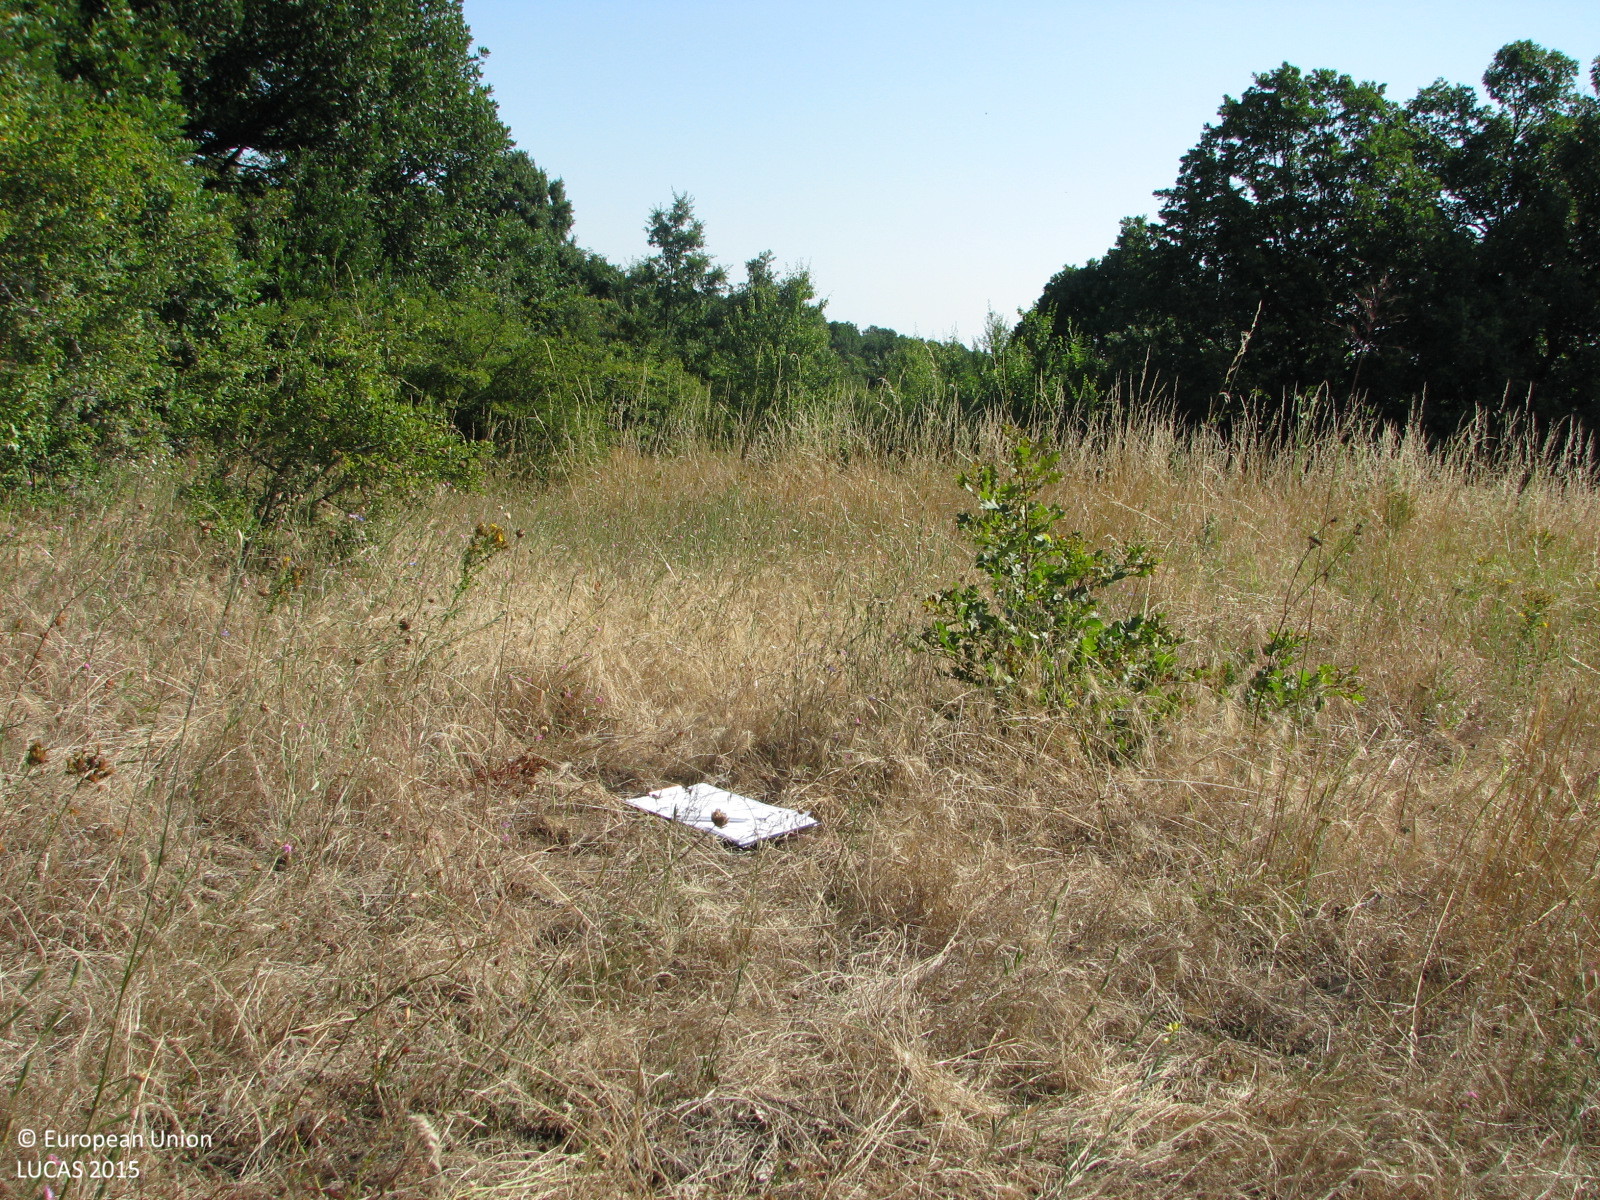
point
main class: Woodland
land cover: Broadleaved woodland
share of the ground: 25 - 50 %
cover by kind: herbaceous plants 50 %, broadleaved forest trees 40 %, shrubs 10 %
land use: Forestry
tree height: < 5 m
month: July
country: BG
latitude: 42.2159
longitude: 26.9002
